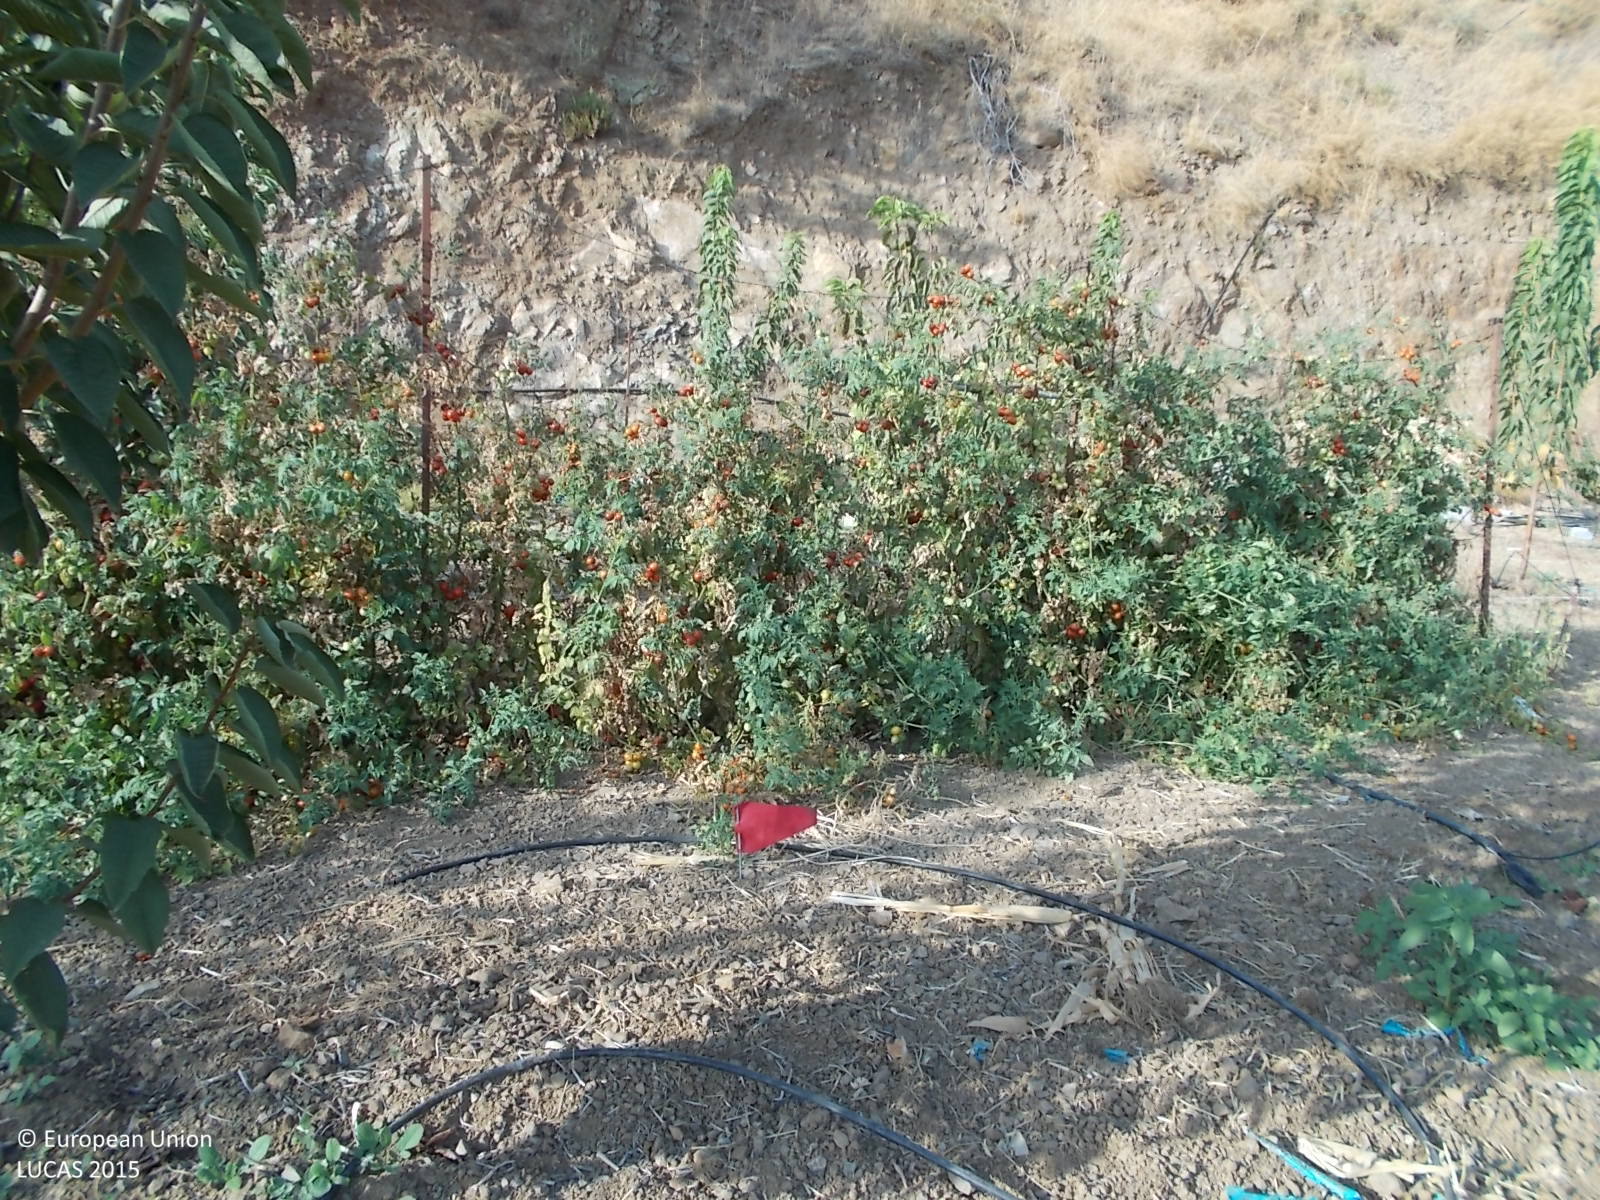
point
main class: Cropland
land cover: Tomatoes
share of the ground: 10 - 25 %
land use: Agriculture (excluding fallow land and kitchen gardens)
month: April
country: CY
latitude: 34.8778
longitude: 33.1849
